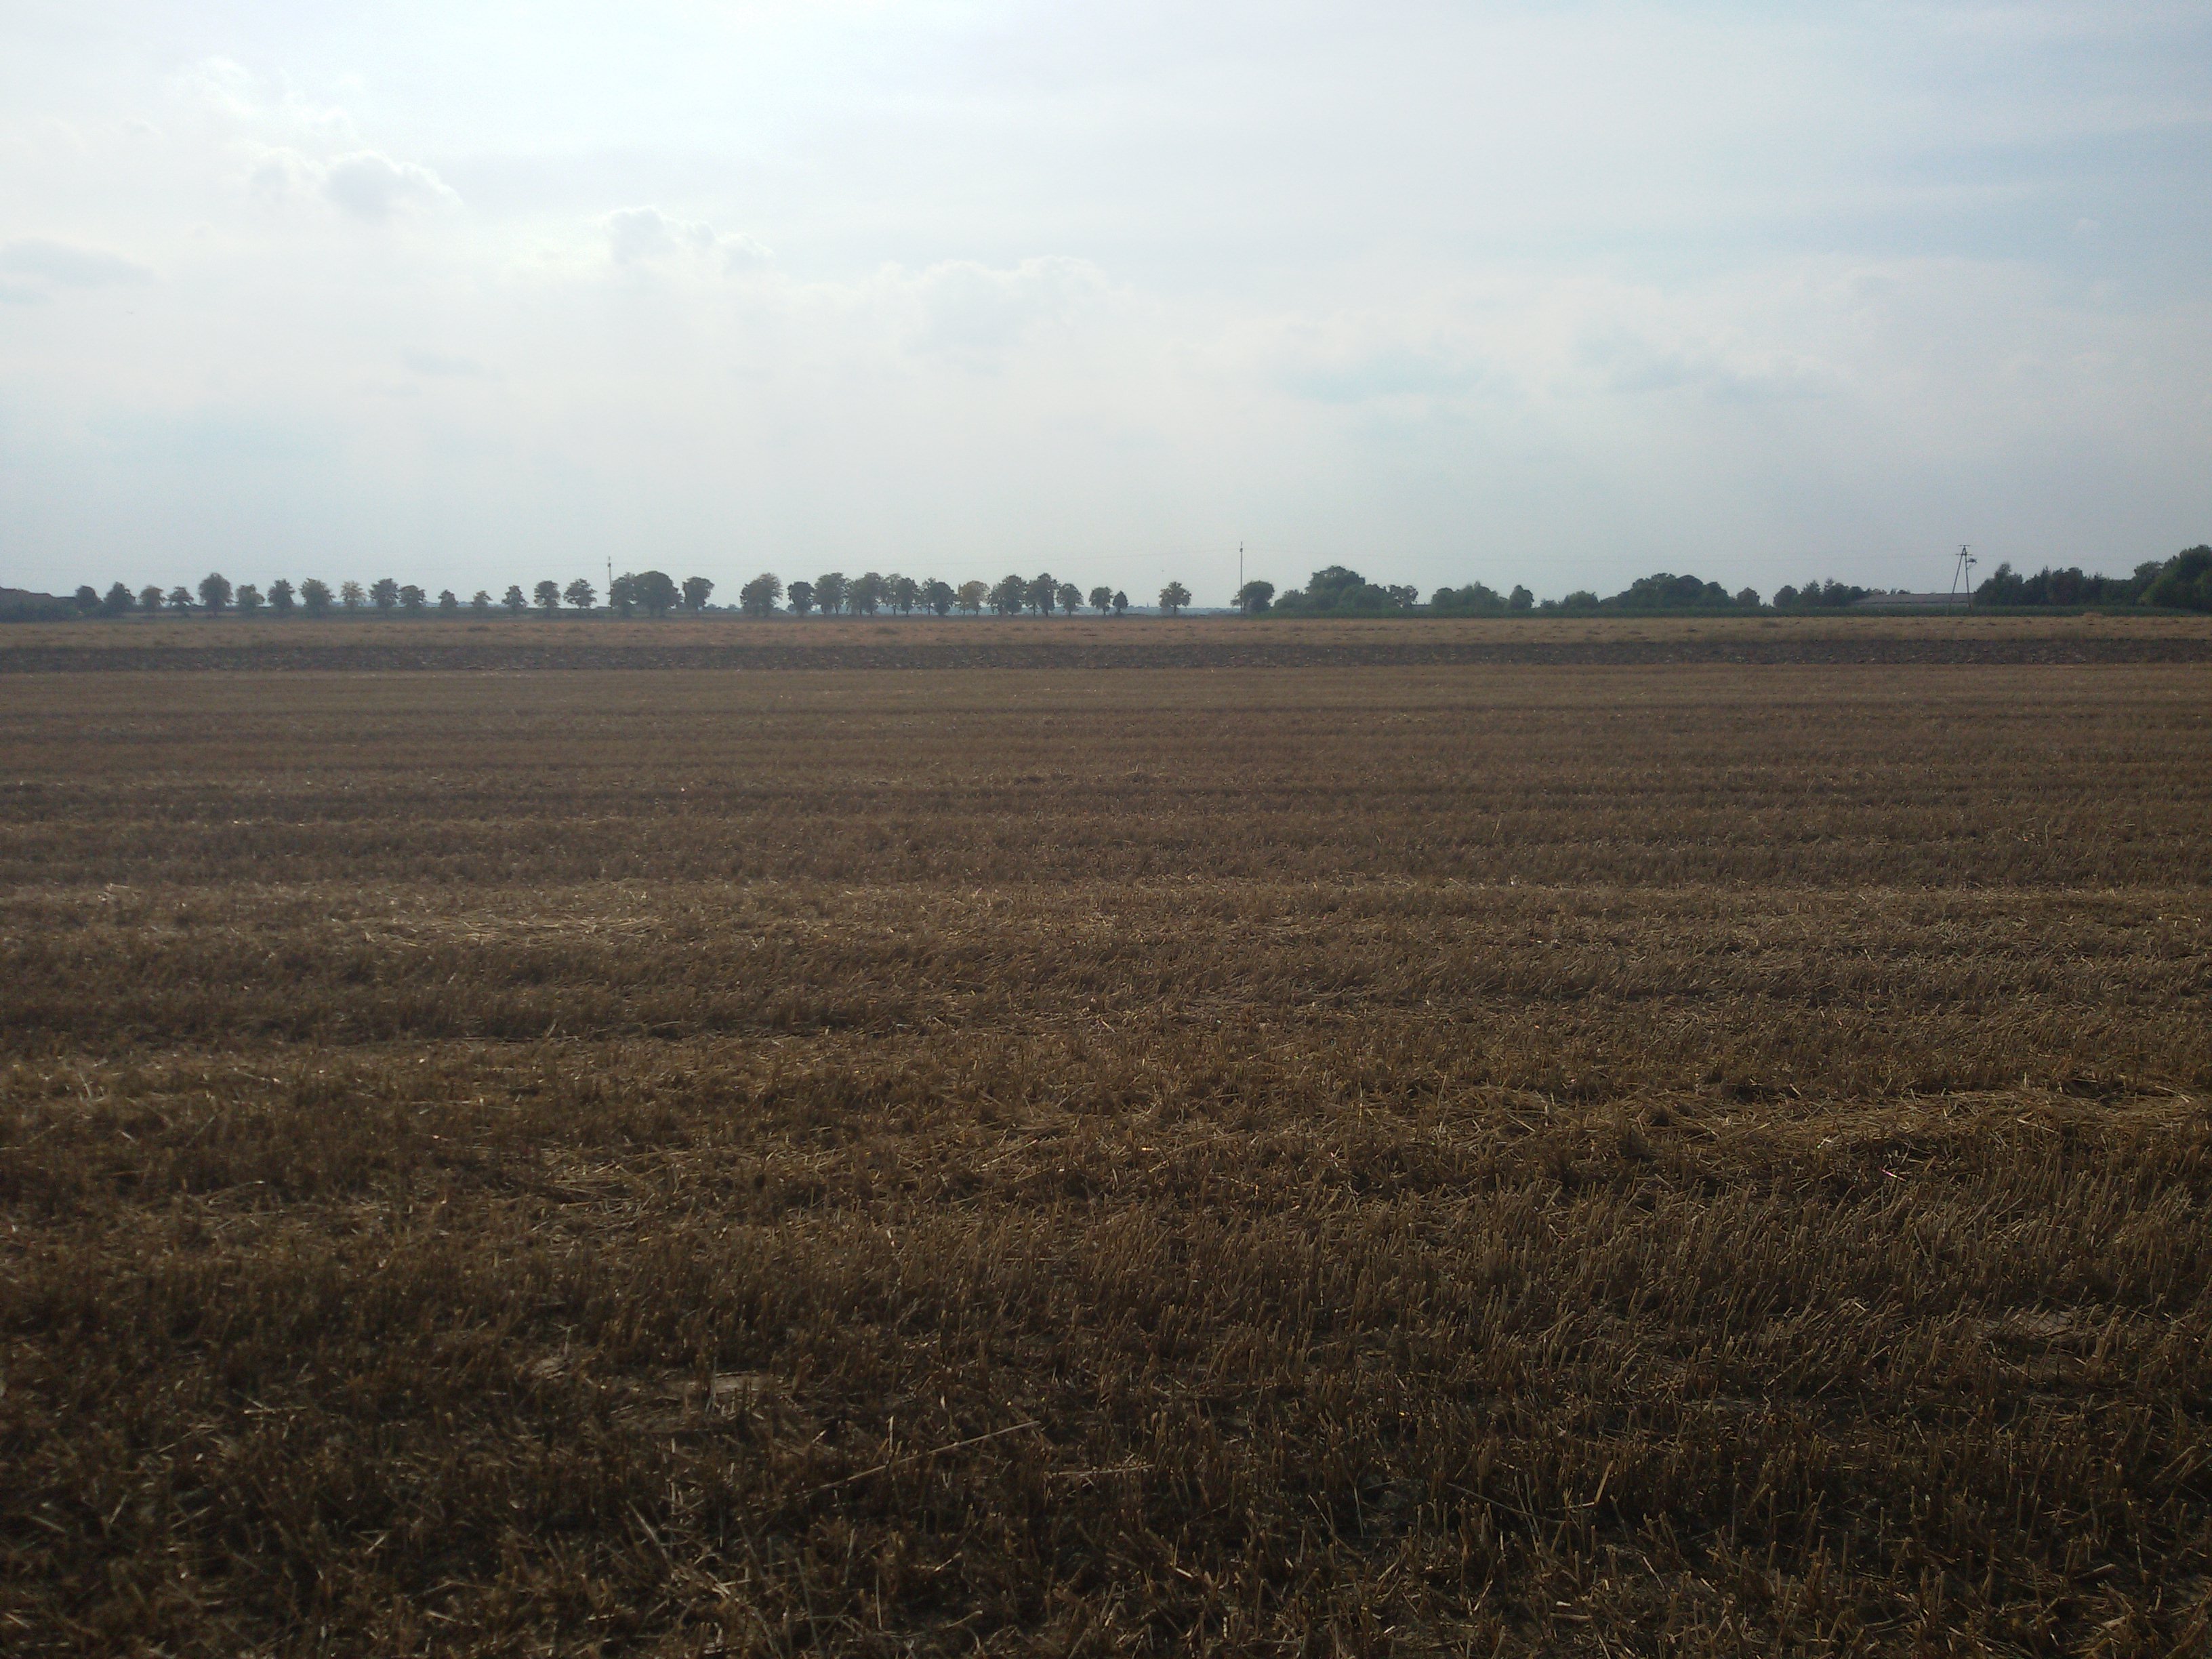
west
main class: Cropland
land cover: Sugar beet
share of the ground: > 75 %
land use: Agriculture (excluding fallow land and kitchen gardens)
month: August
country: PL
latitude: 51.8020
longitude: 17.4227
